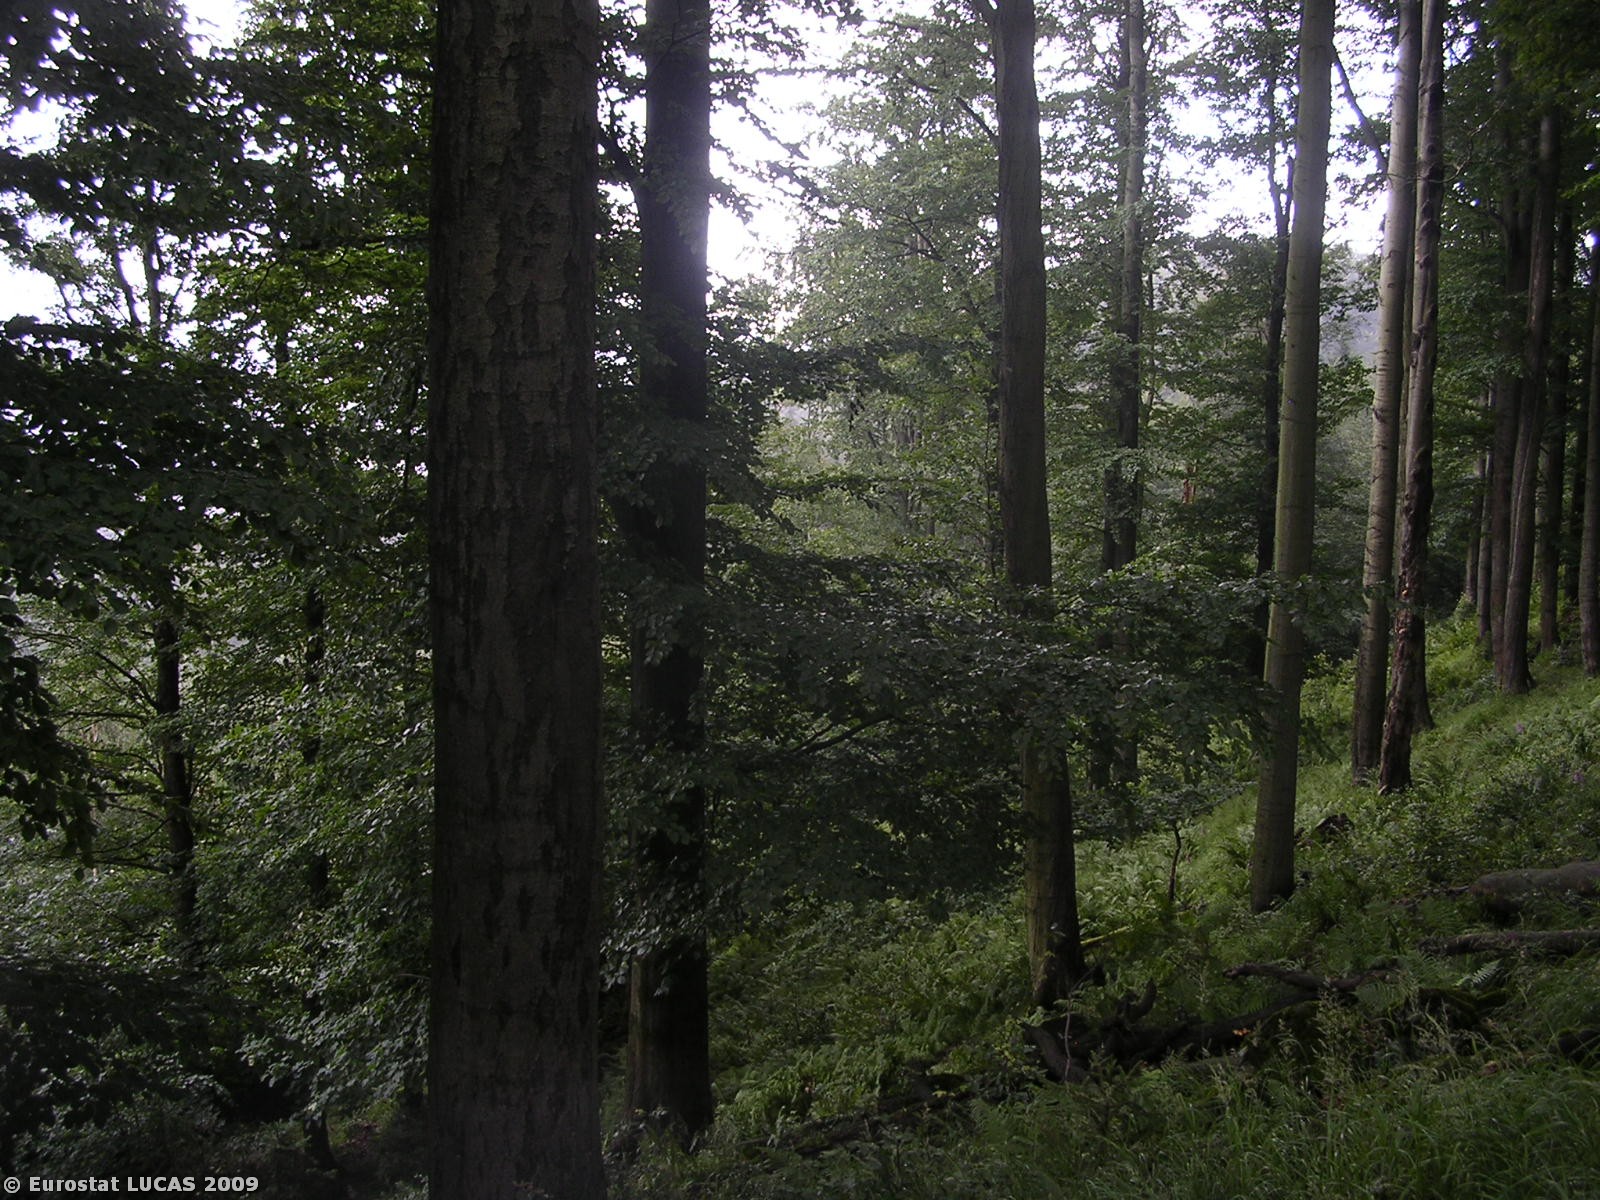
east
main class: Woodland
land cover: Broadleaved woodland
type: mountainous beech forest
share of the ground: > 75 %
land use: Forestry
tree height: > 5 m
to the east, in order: Broadleaved woodland; Coniferous woodland; Mixed woodland; Coniferous woodland; Tracks; Coniferous woodland
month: July
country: CZ
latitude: 50.7956
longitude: 14.5561
